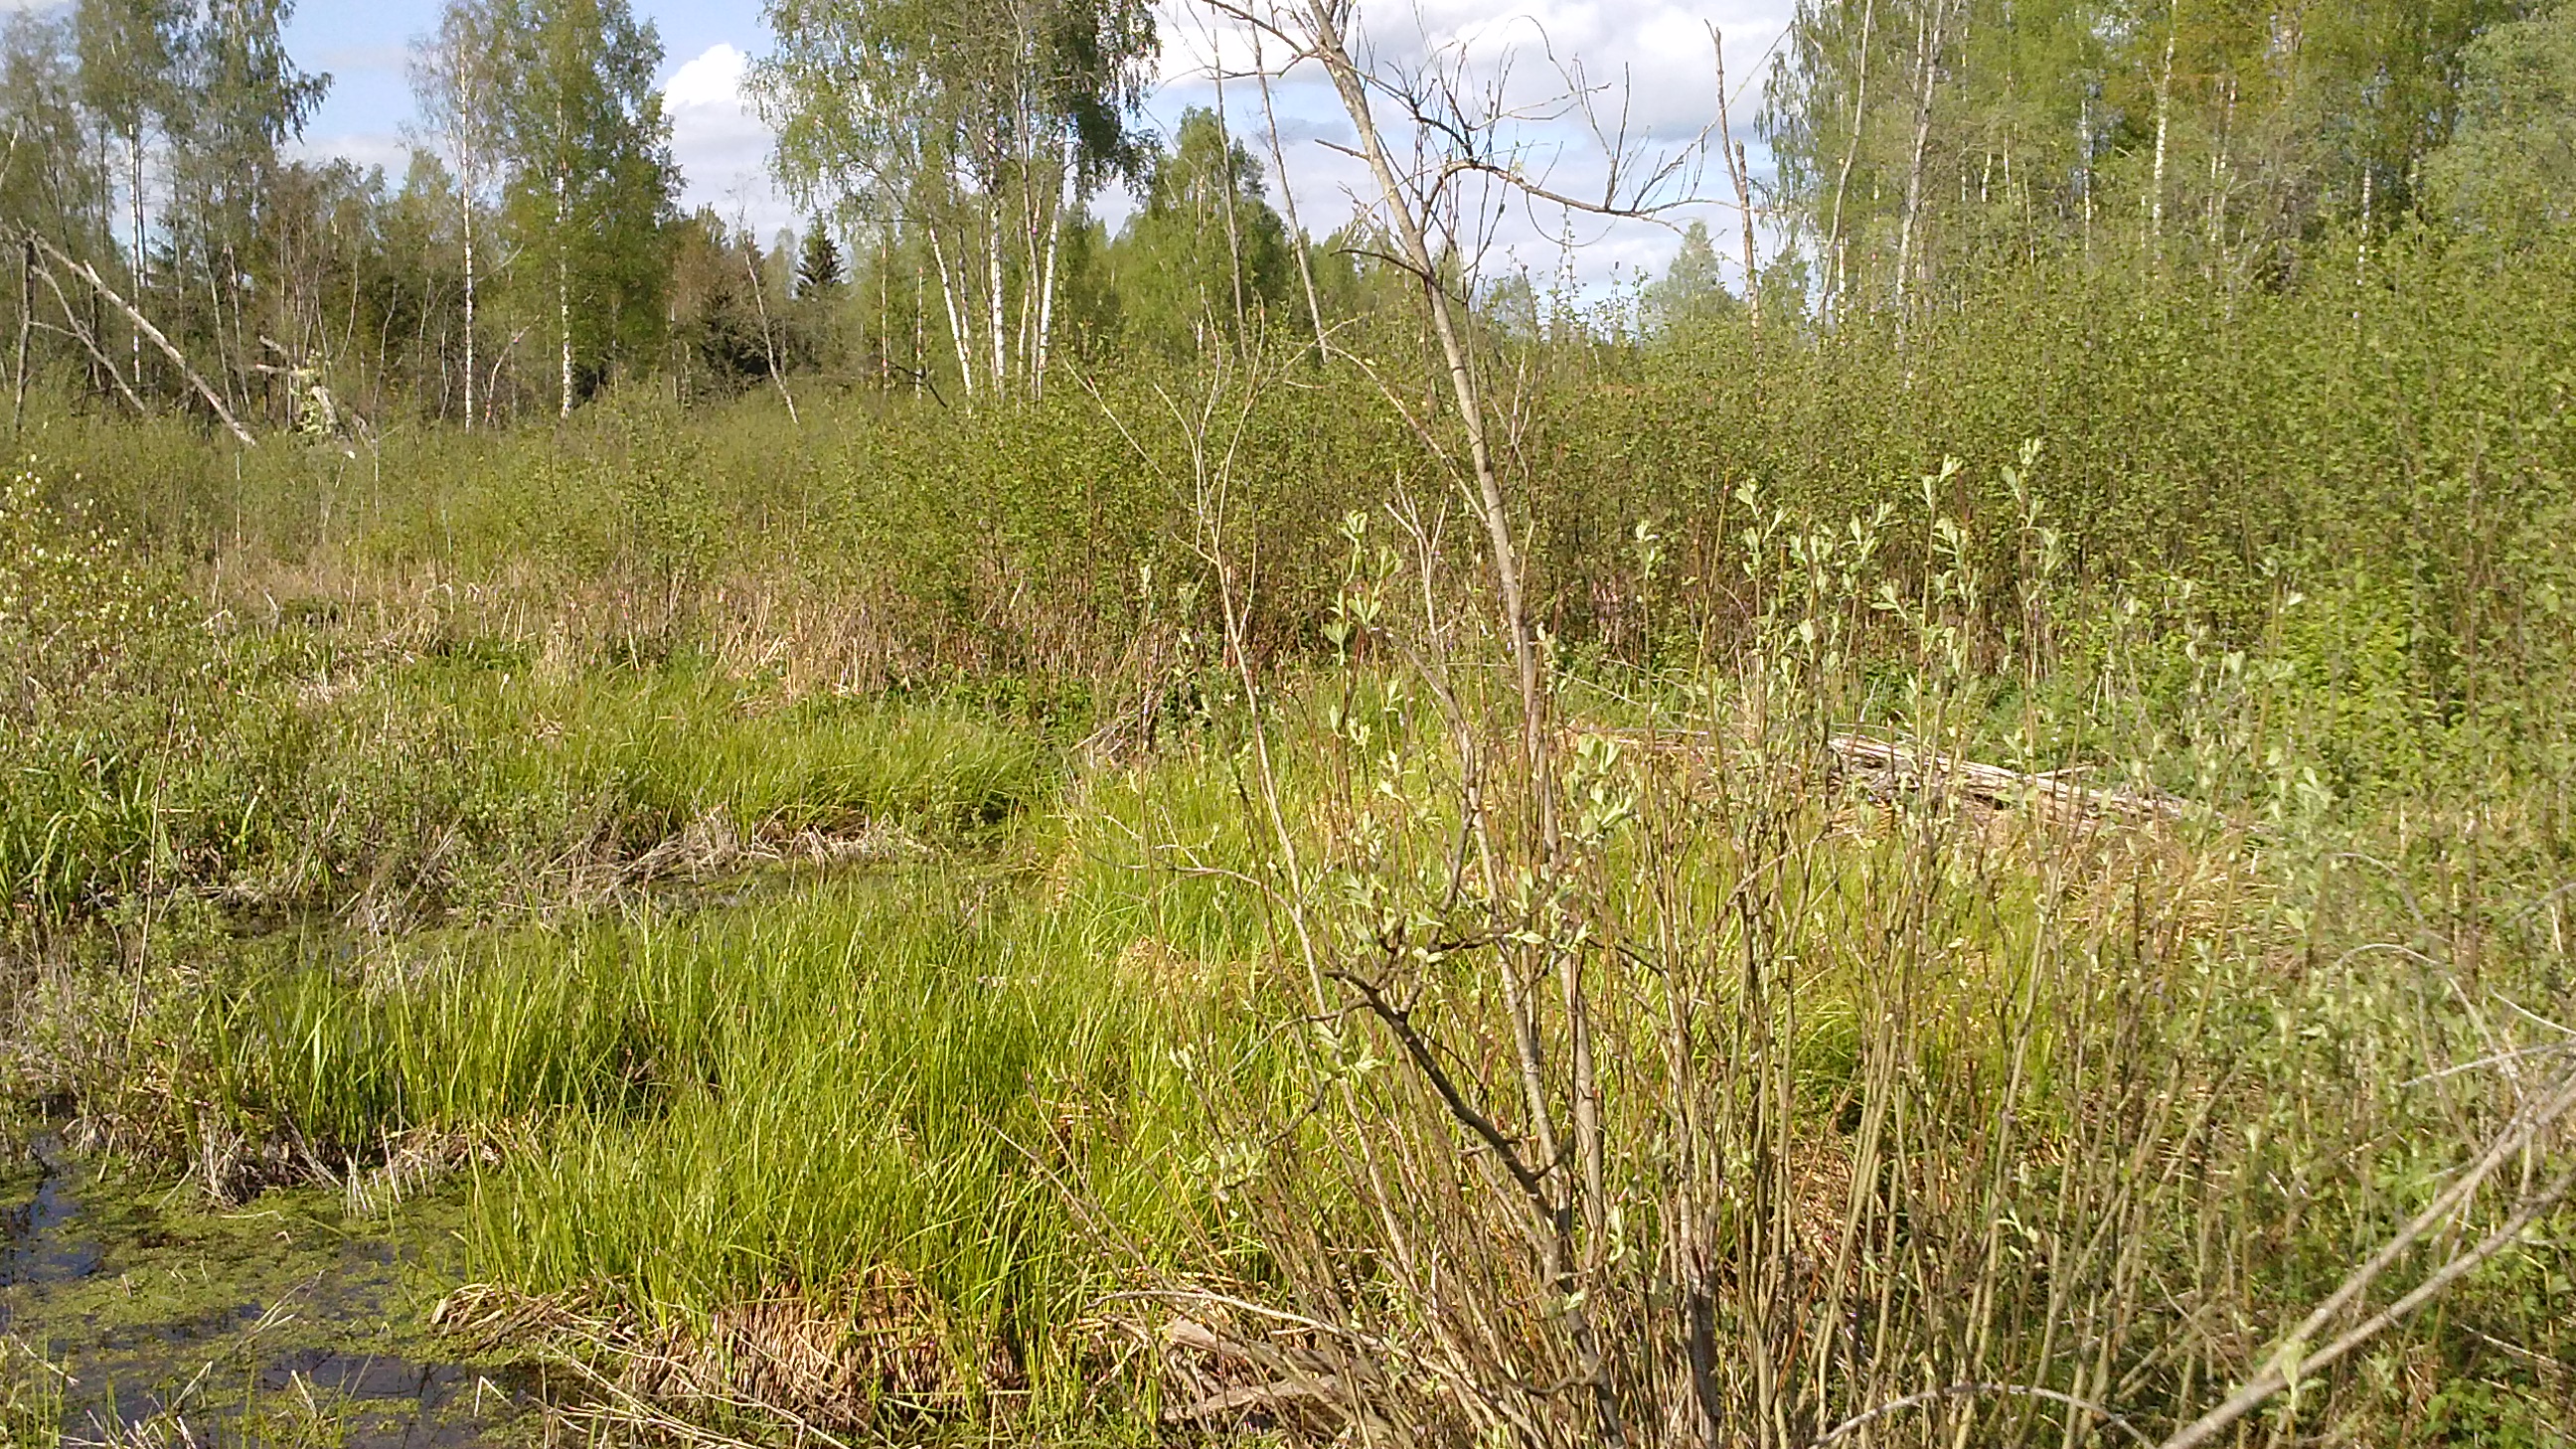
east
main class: Woodland
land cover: Broadleaved woodland
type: non-riverine alder, birch or aspen forest
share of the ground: > 75 %
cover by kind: broadleaved forest trees 100 %
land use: Forestry
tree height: > 5 m
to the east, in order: Broadleaved woodland; Spontaneously vegetated surfaces; Broadleaved woodland; Spontaneously vegetated surfaces; Single bushes/trees; Spontaneously vegetated surfaces; Other mixed woodland
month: May
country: LV
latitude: 56.1056
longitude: 27.6975
